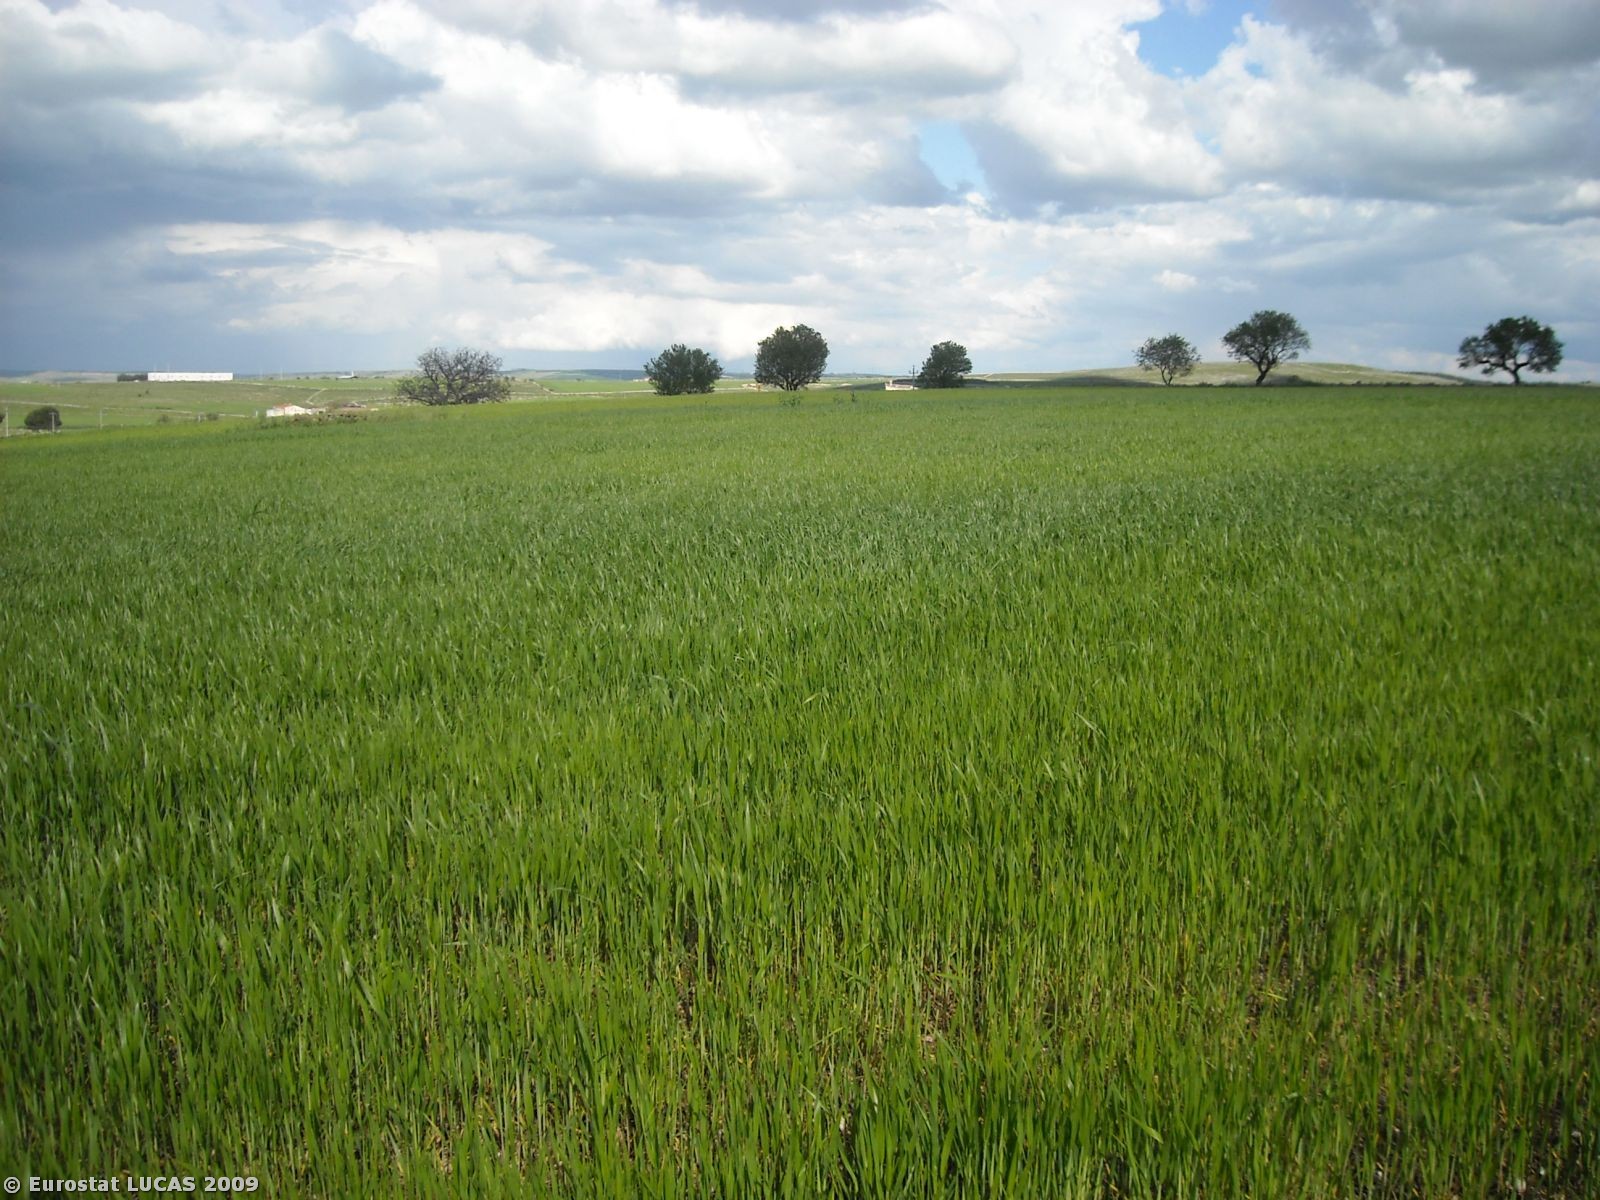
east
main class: Cropland
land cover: Durum wheat
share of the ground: > 75 %
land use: Agriculture (excluding fallow land and kitchen gardens)
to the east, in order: Durum wheat; Spontaneously vegetated surfaces; Bare land; Grass margins; Dry stone walls; Grass margins; Durum wheat; Electric lines; Durum wheat
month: April
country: IT
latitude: 40.7708
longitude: 16.6003
